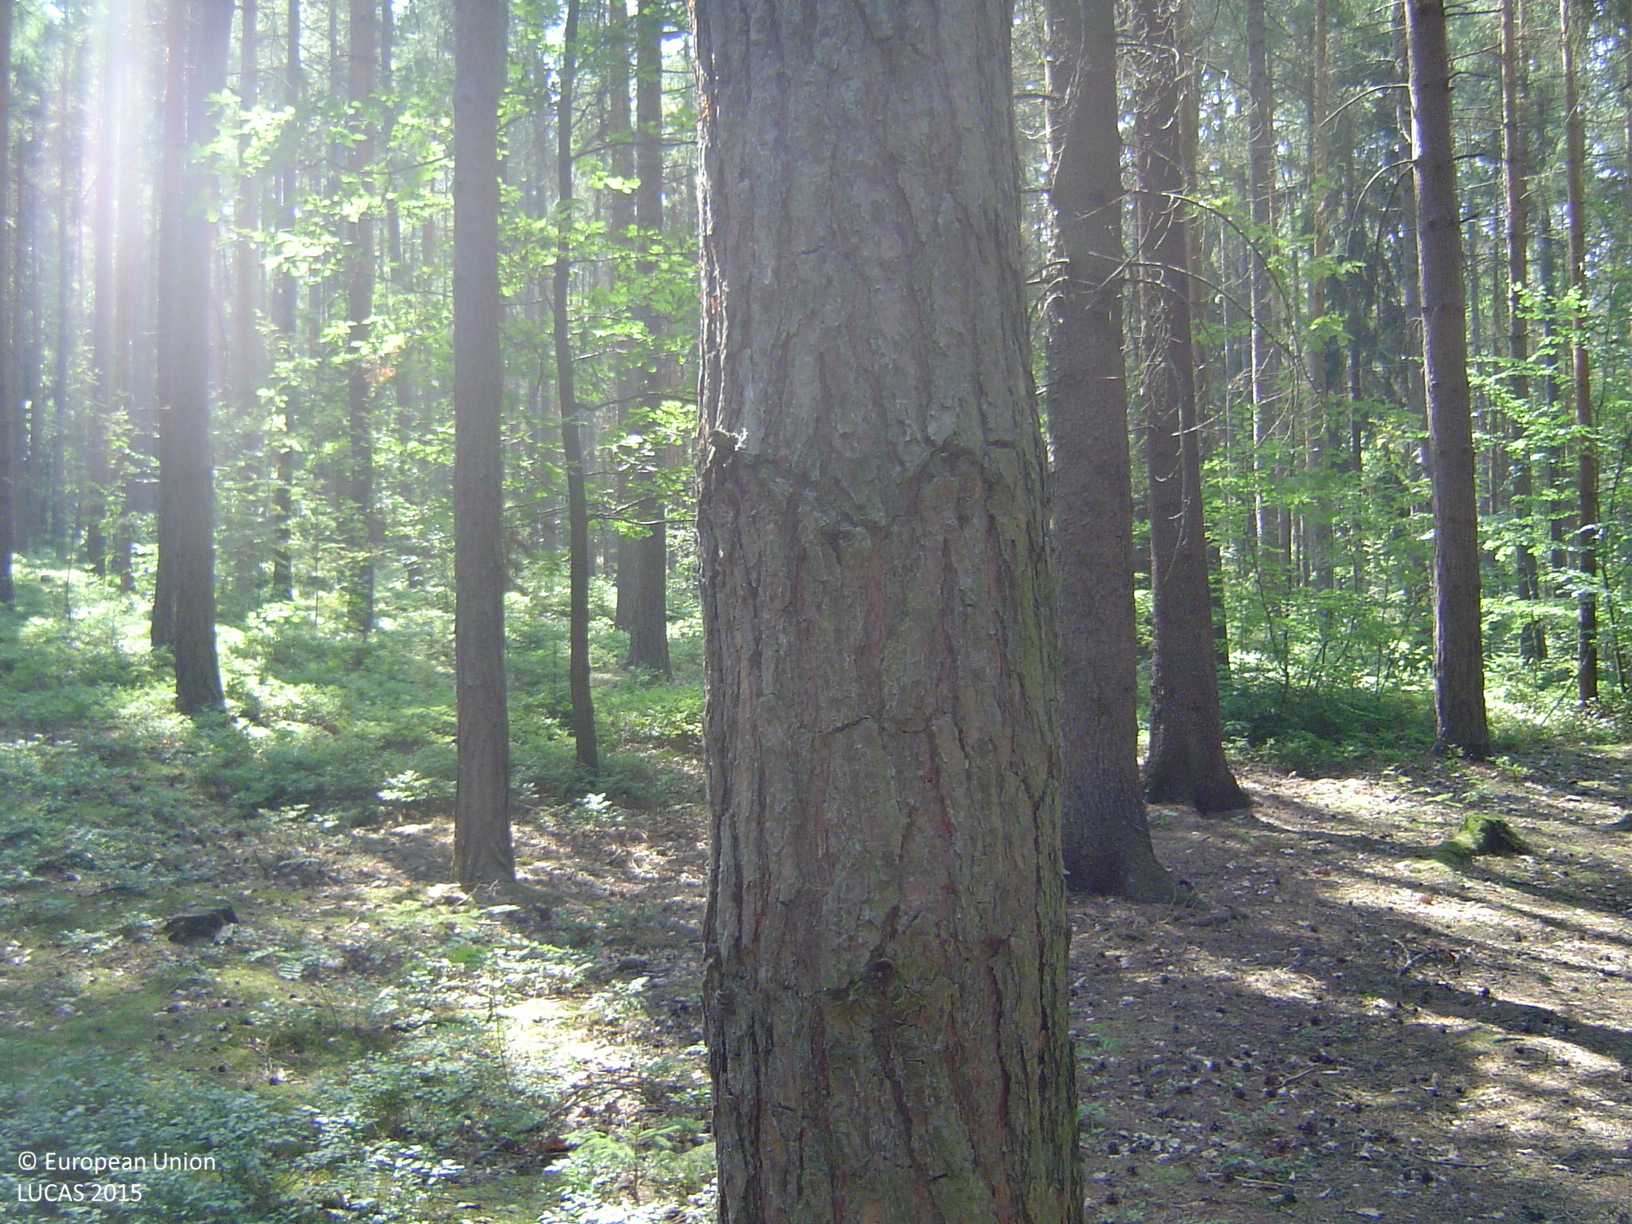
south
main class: Woodland
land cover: Pine dominated mixed woodland
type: hemiboreal forest and nemoral coniferous forest and mixed broadleaved-coniferous forest
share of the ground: > 75 %
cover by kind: coniferous forest trees 70 %, broadleaved forest trees 25 %, herbaceous plants 5 %
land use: Forestry
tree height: > 5 m
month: August
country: CZ
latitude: 50.1732
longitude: 13.8512
